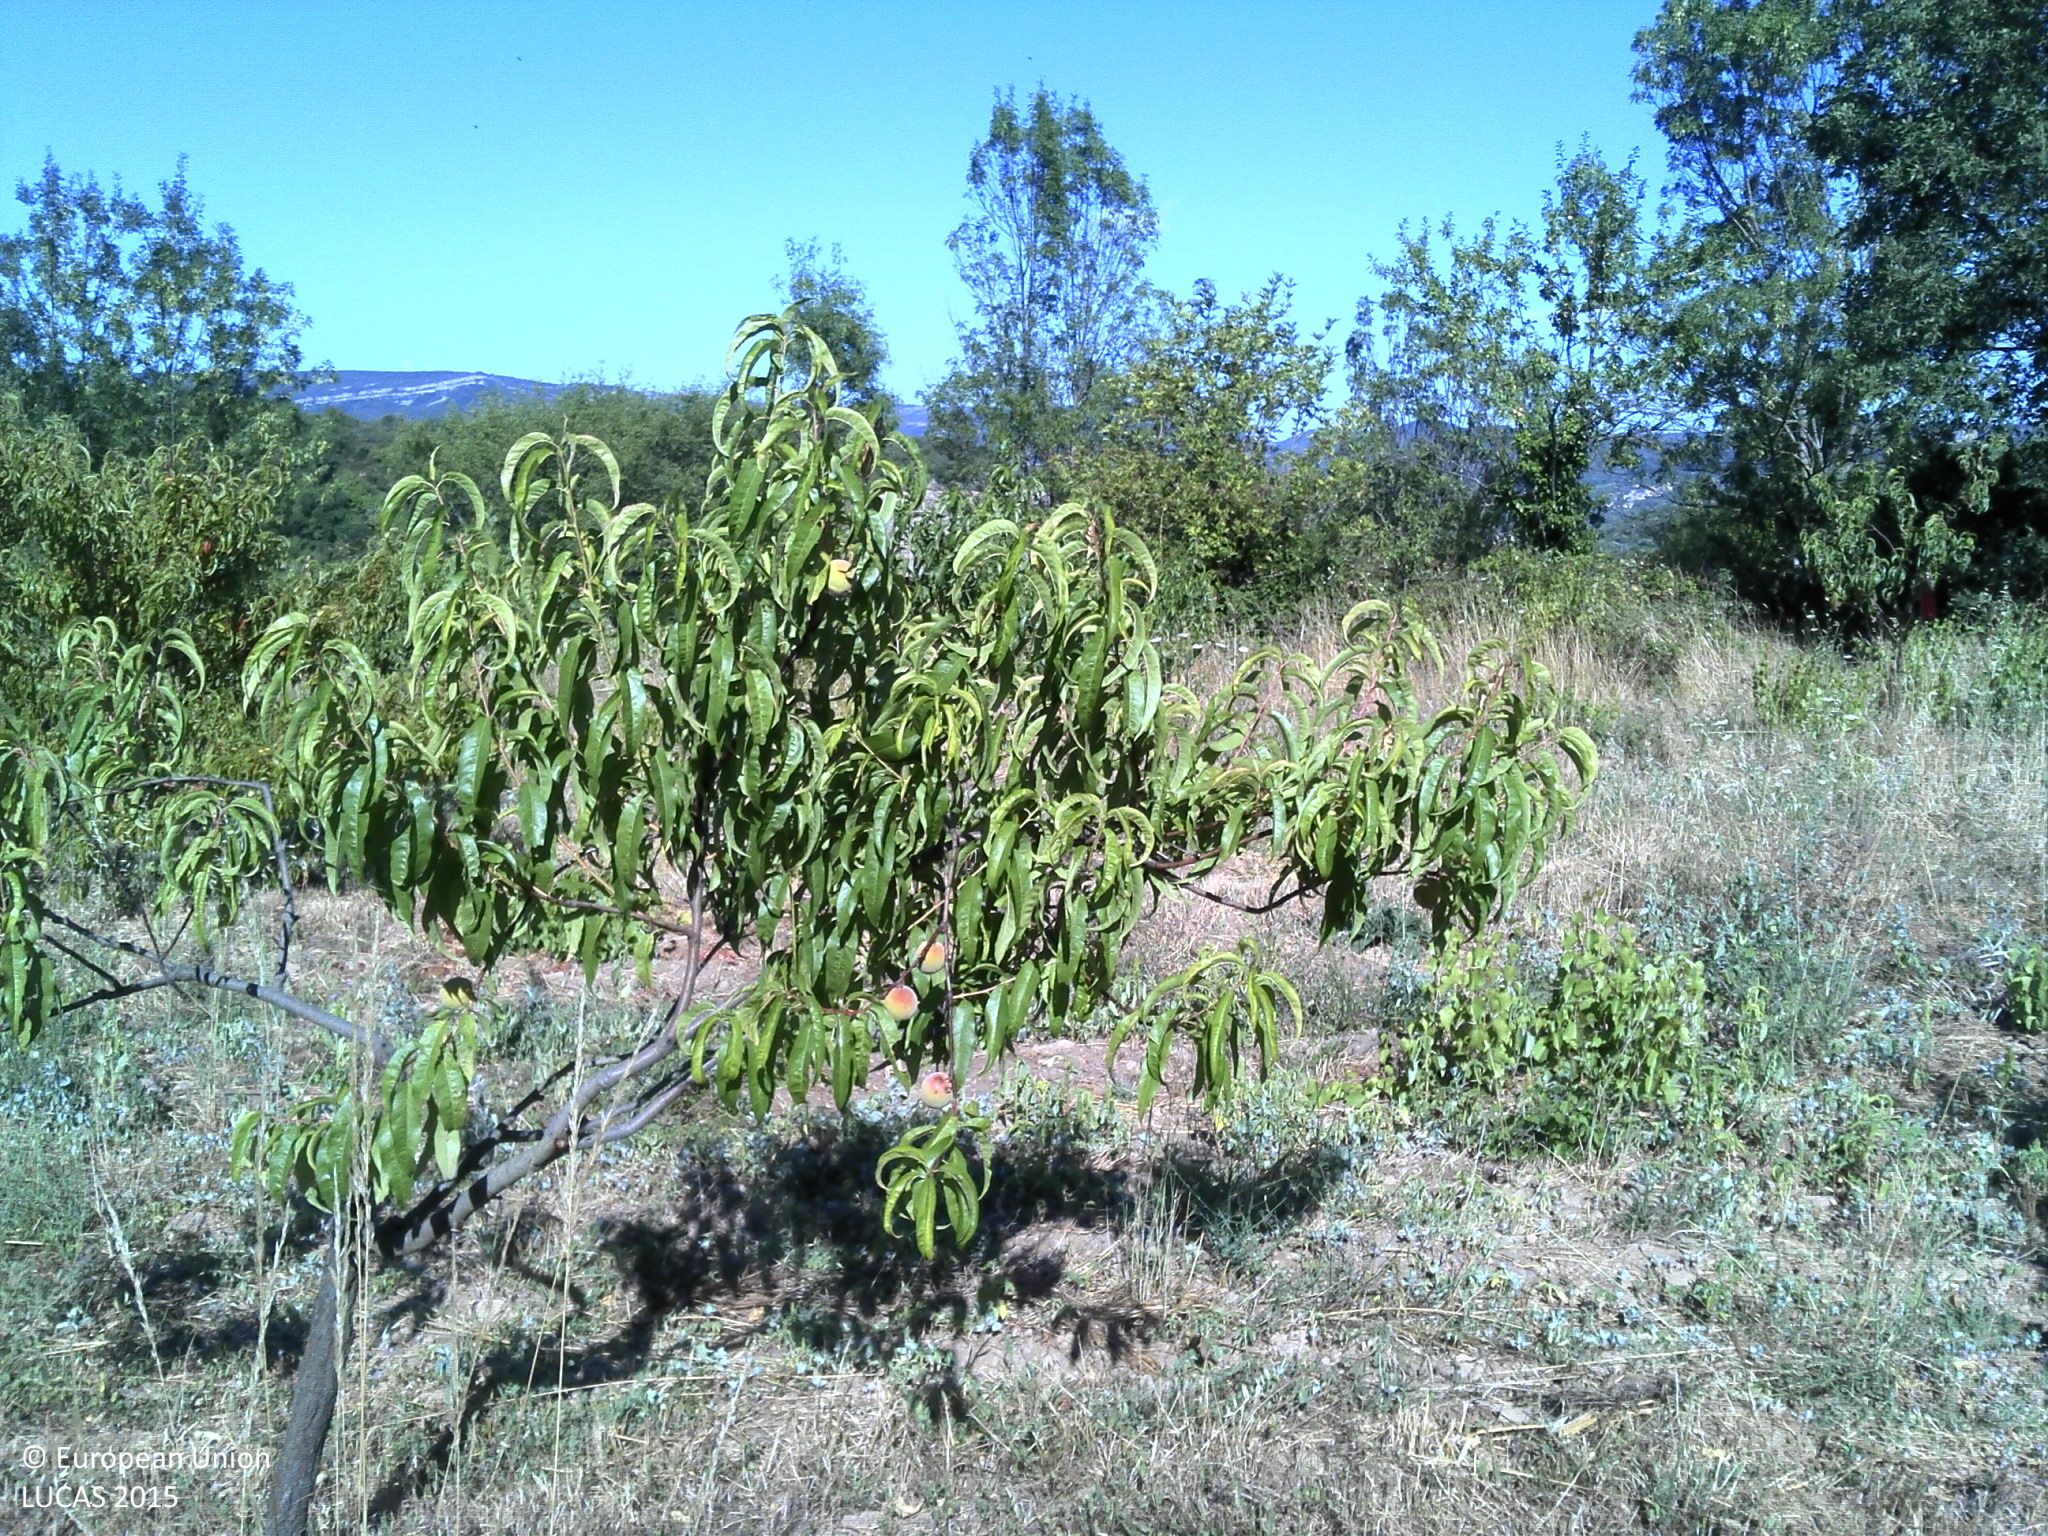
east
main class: Cropland
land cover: Other fruit trees and berries
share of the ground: 10 - 25 %
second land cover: Spontaneously vegetated surfaces
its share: > 75 %
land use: Agriculture (excluding fallow land and kitchen gardens)
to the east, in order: Other fruit trees and berries; Spontaneously vegetated surfaces; Lines of trees; Abandoned hedges; Grassland with sparse tree/shrub cover; Other fruit trees and berries; Grassland with sparse tree/shrub cover; Abandoned hedges; Fences; Lines of trees; Grassland with sparse tree/shrub cover; Other fruit trees and berries; Broadleaved woodland; Grassland with sparse tree/shrub cover; Fences; Abandoned hedges; Dry stone walls; Paved roads, cycling and walking lanes; Grass margins; Paved roads, cycling and walking lanes; Rocks and stones; Artificial constructions in urban areas; Broadleaved woodland; Artificial constructions in urban areas
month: July
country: FR
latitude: 43.6519
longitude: 3.1267
